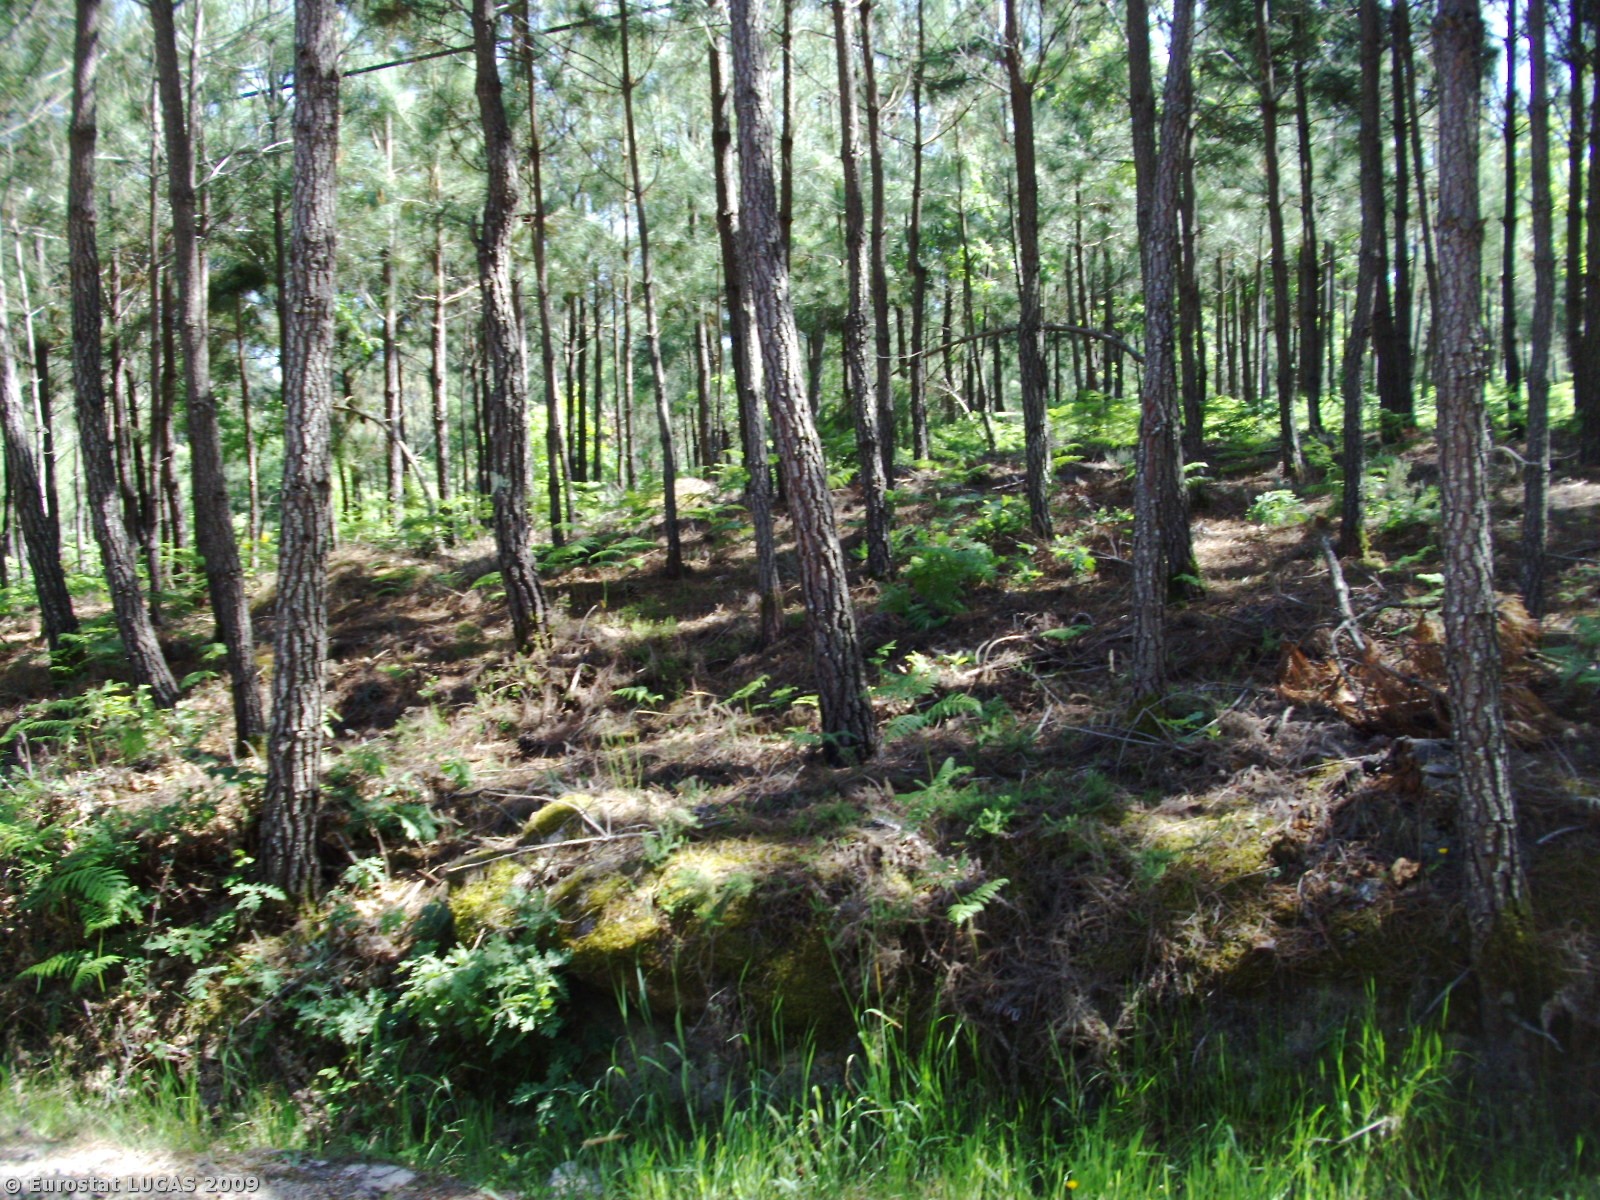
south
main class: Woodland
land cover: Coniferous woodland
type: coniferous forest of the mediterranean region
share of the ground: > 75 %
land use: Forestry
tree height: > 5 m
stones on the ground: 25 - 50 %
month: May
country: PT
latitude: 40.8154
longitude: -7.5328
